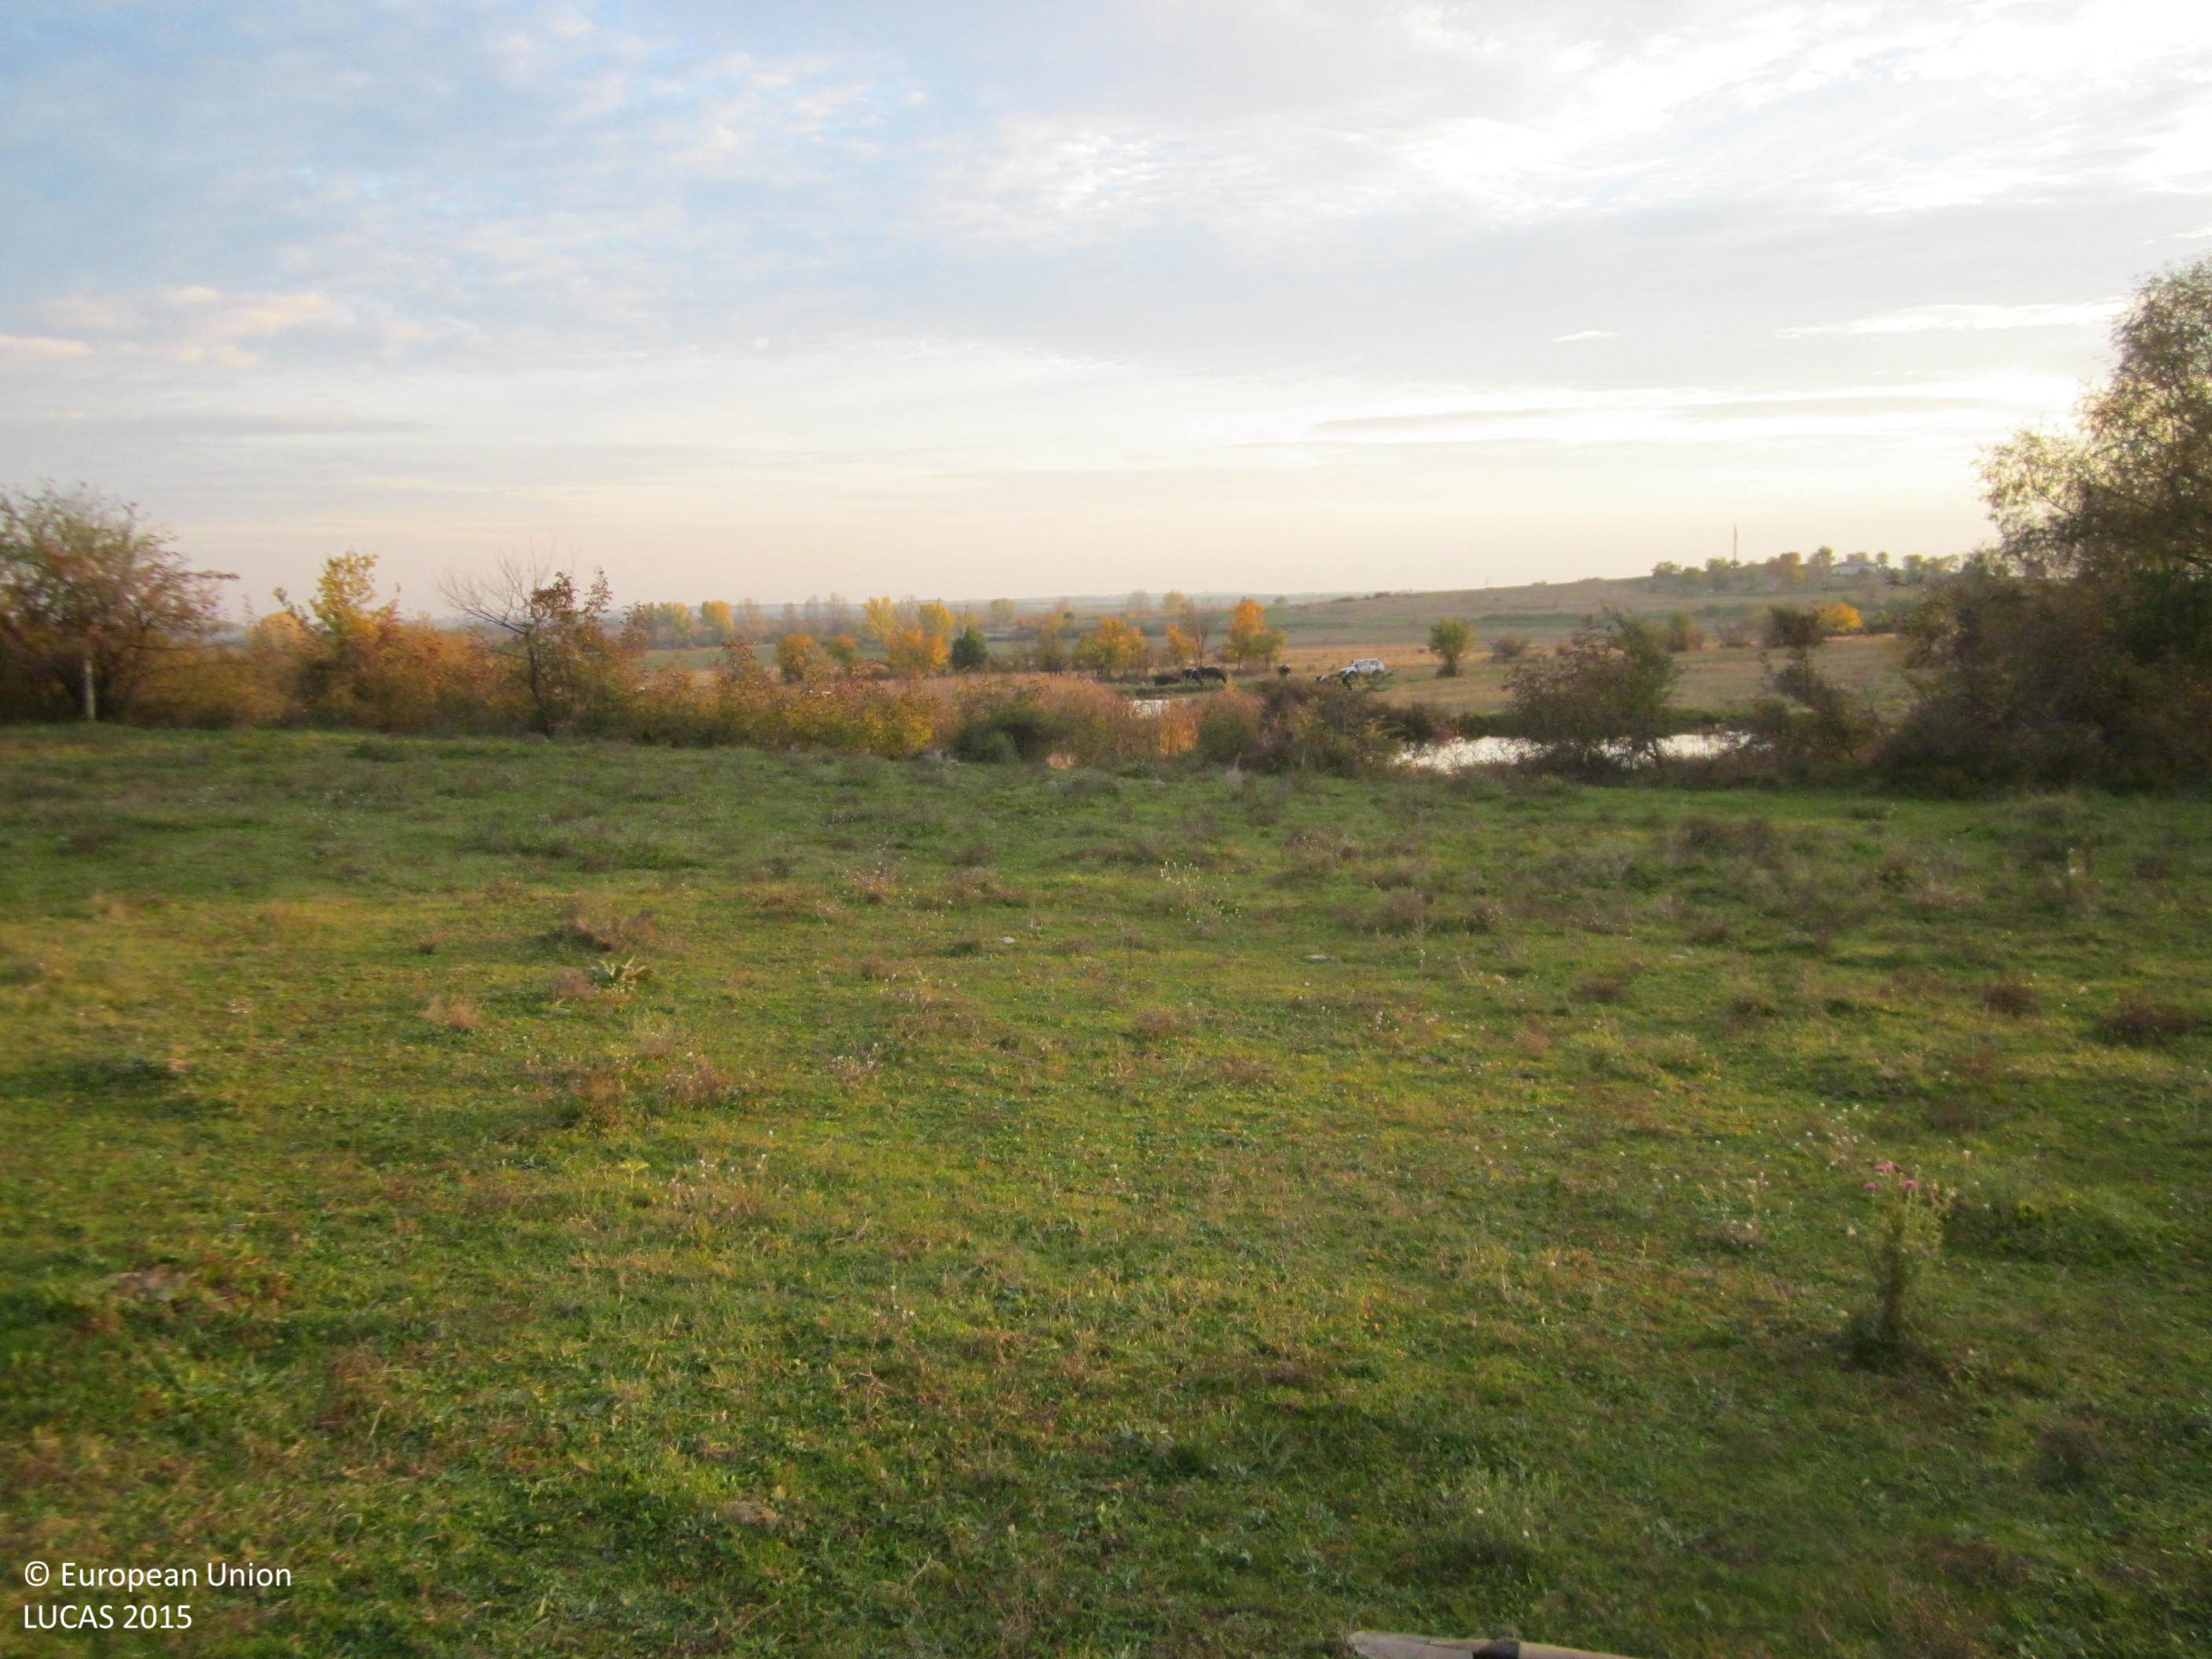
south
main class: Grassland
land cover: Grassland without tree/shrub cover
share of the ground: > 75 %
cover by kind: herbaceous plants 100 %
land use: Agriculture (excluding fallow land and kitchen gardens)
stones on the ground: < 10 %
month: November
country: BG
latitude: 42.4639
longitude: 24.6347
